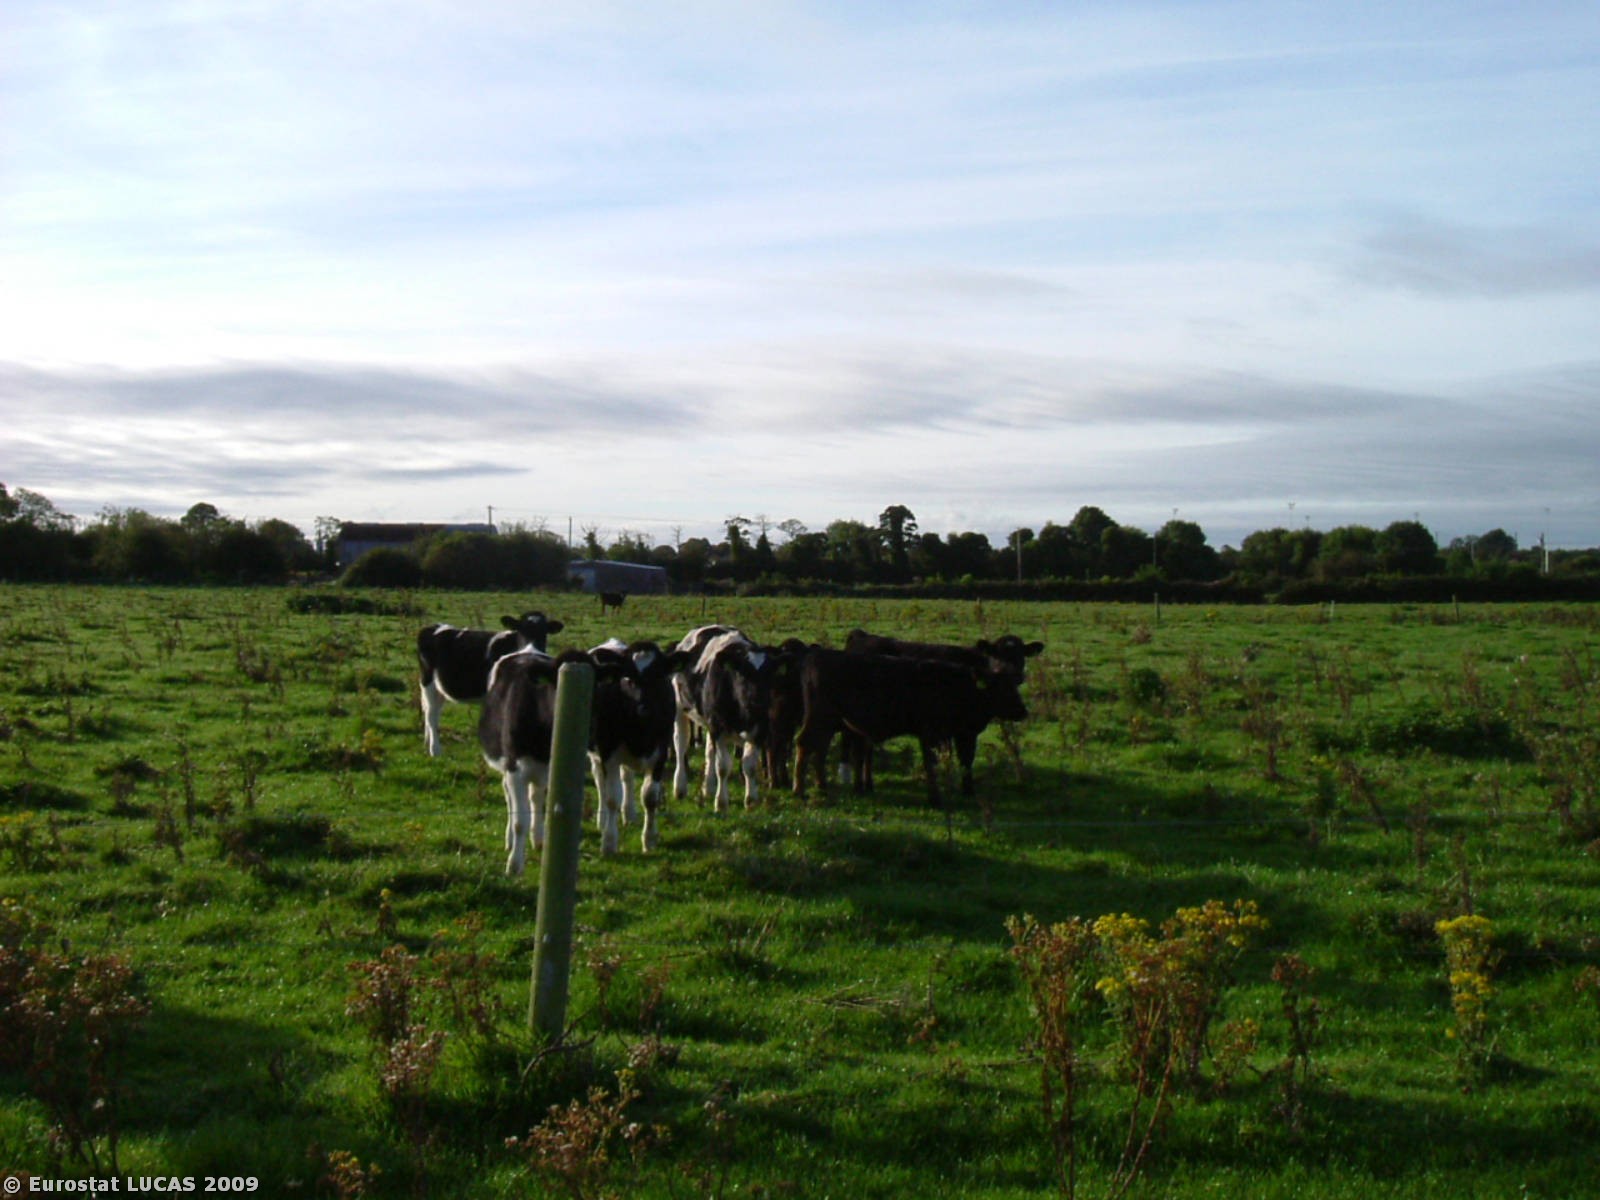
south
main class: Grassland
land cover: Grassland without tree/shrub cover
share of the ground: > 75 %
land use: Agriculture (excluding fallow land and kitchen gardens)
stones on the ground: < 10 %
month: October
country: IE
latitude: 52.6477
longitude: -7.7409
